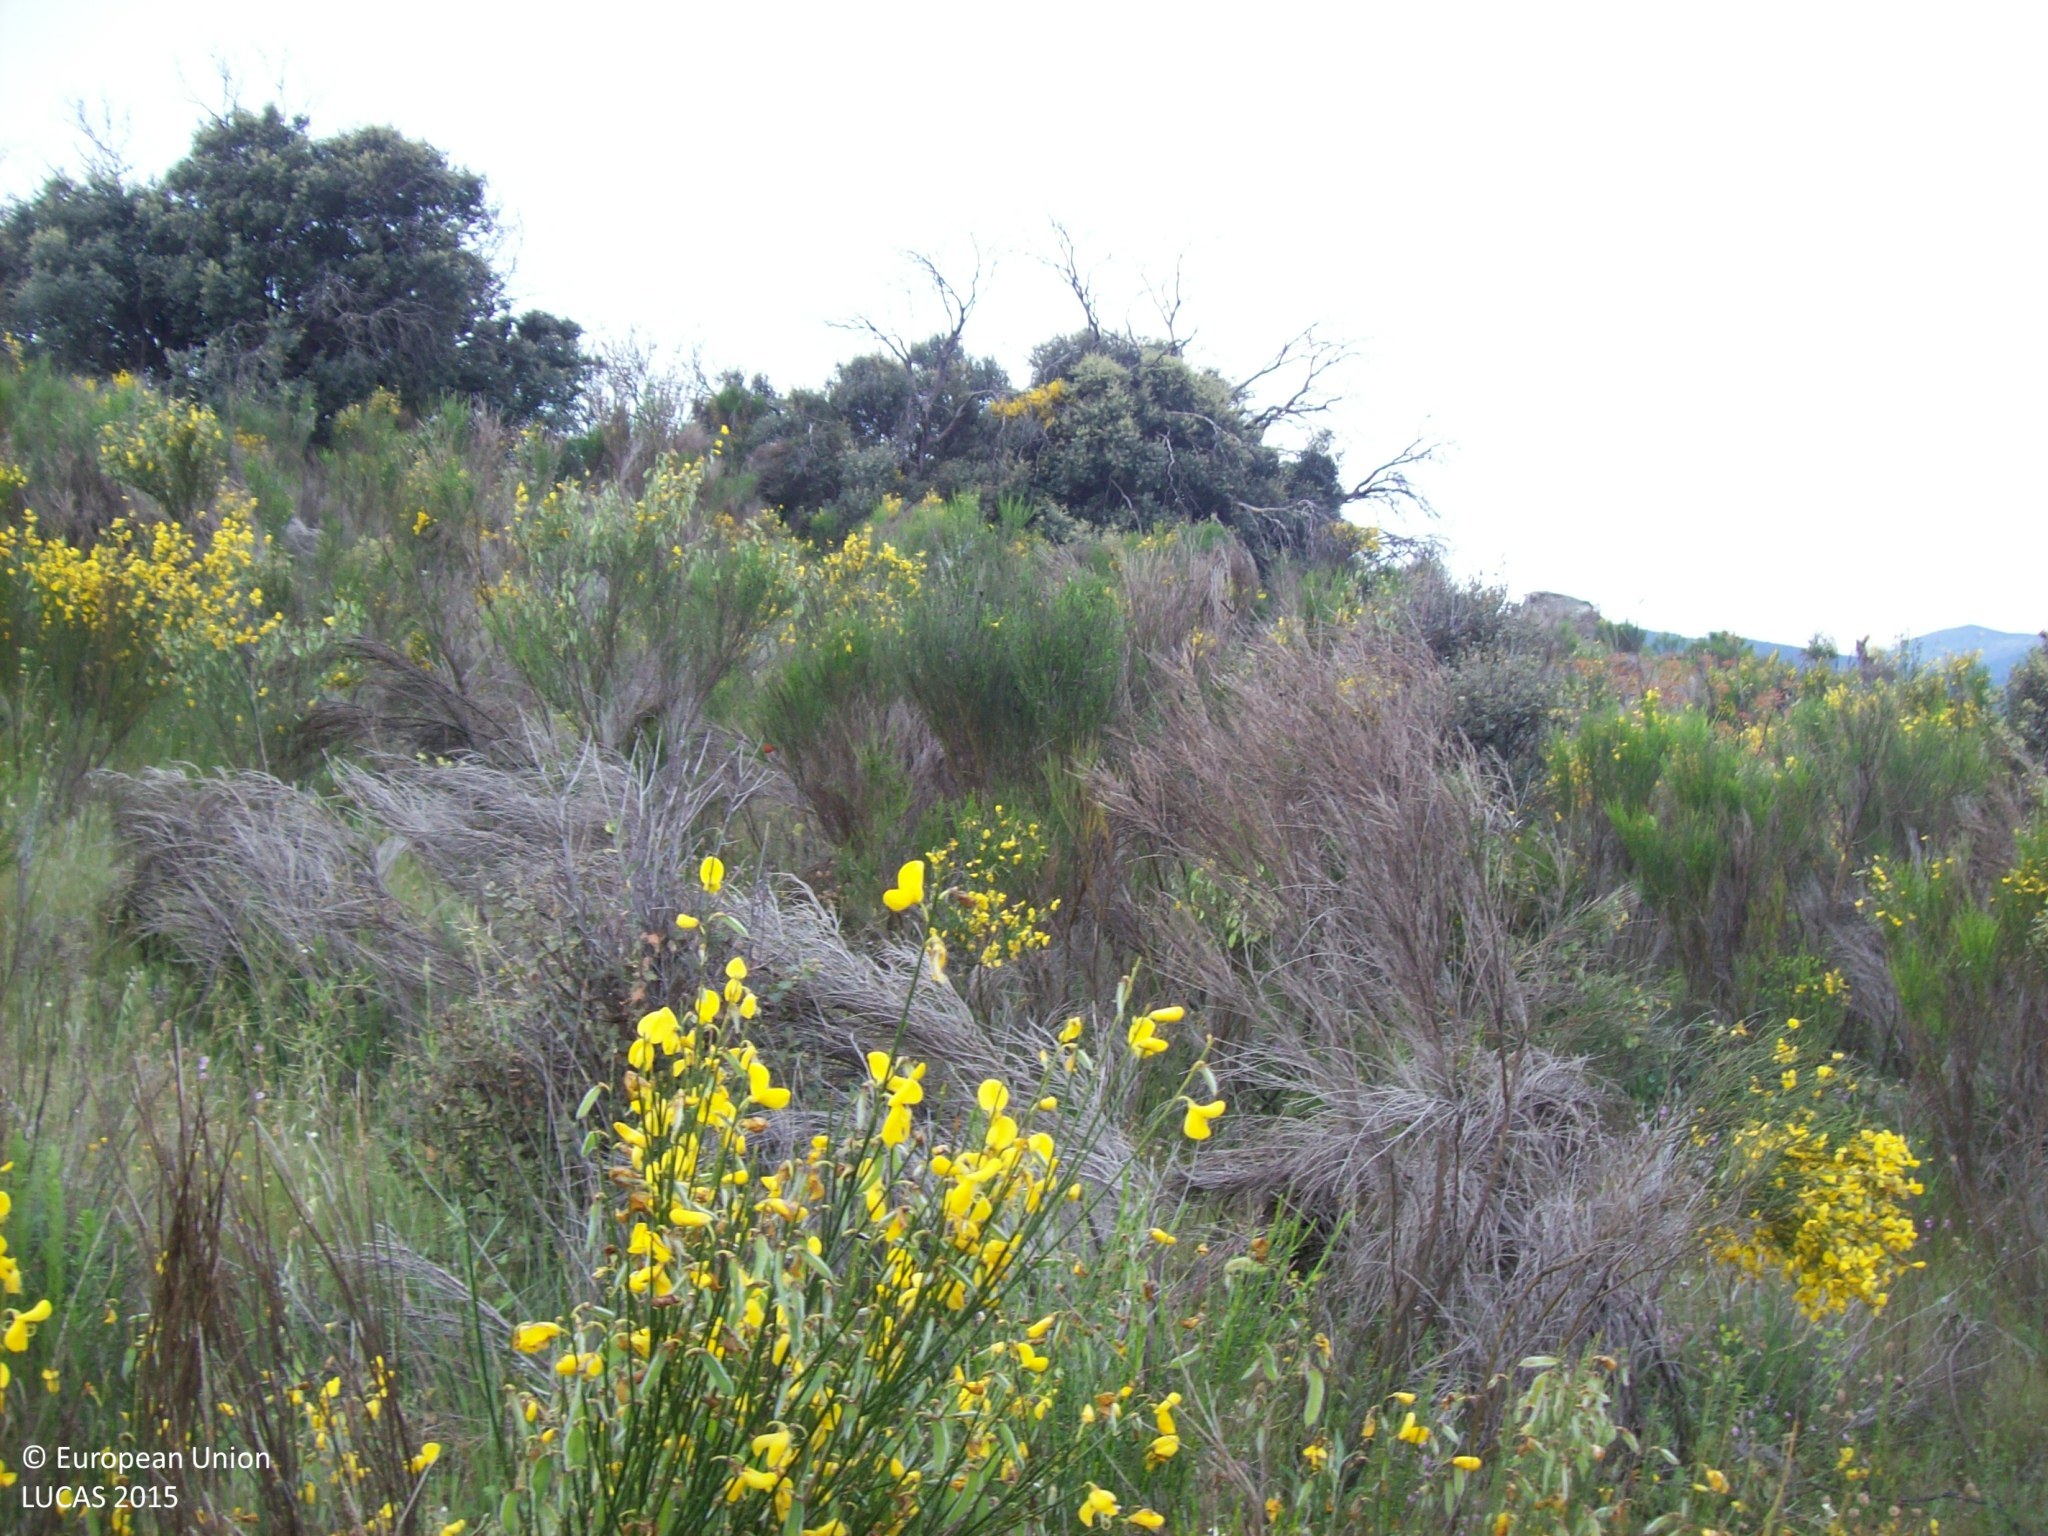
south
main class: Shrubland
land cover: Shrubland without tree cover
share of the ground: 25 - 50 %
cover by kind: herbaceous plants 55 %, shrubs 40 %, consolidated bare surface 5 %
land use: Abandoned areas
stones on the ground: < 10 %
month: April
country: ES
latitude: 40.4220
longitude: -4.4390
